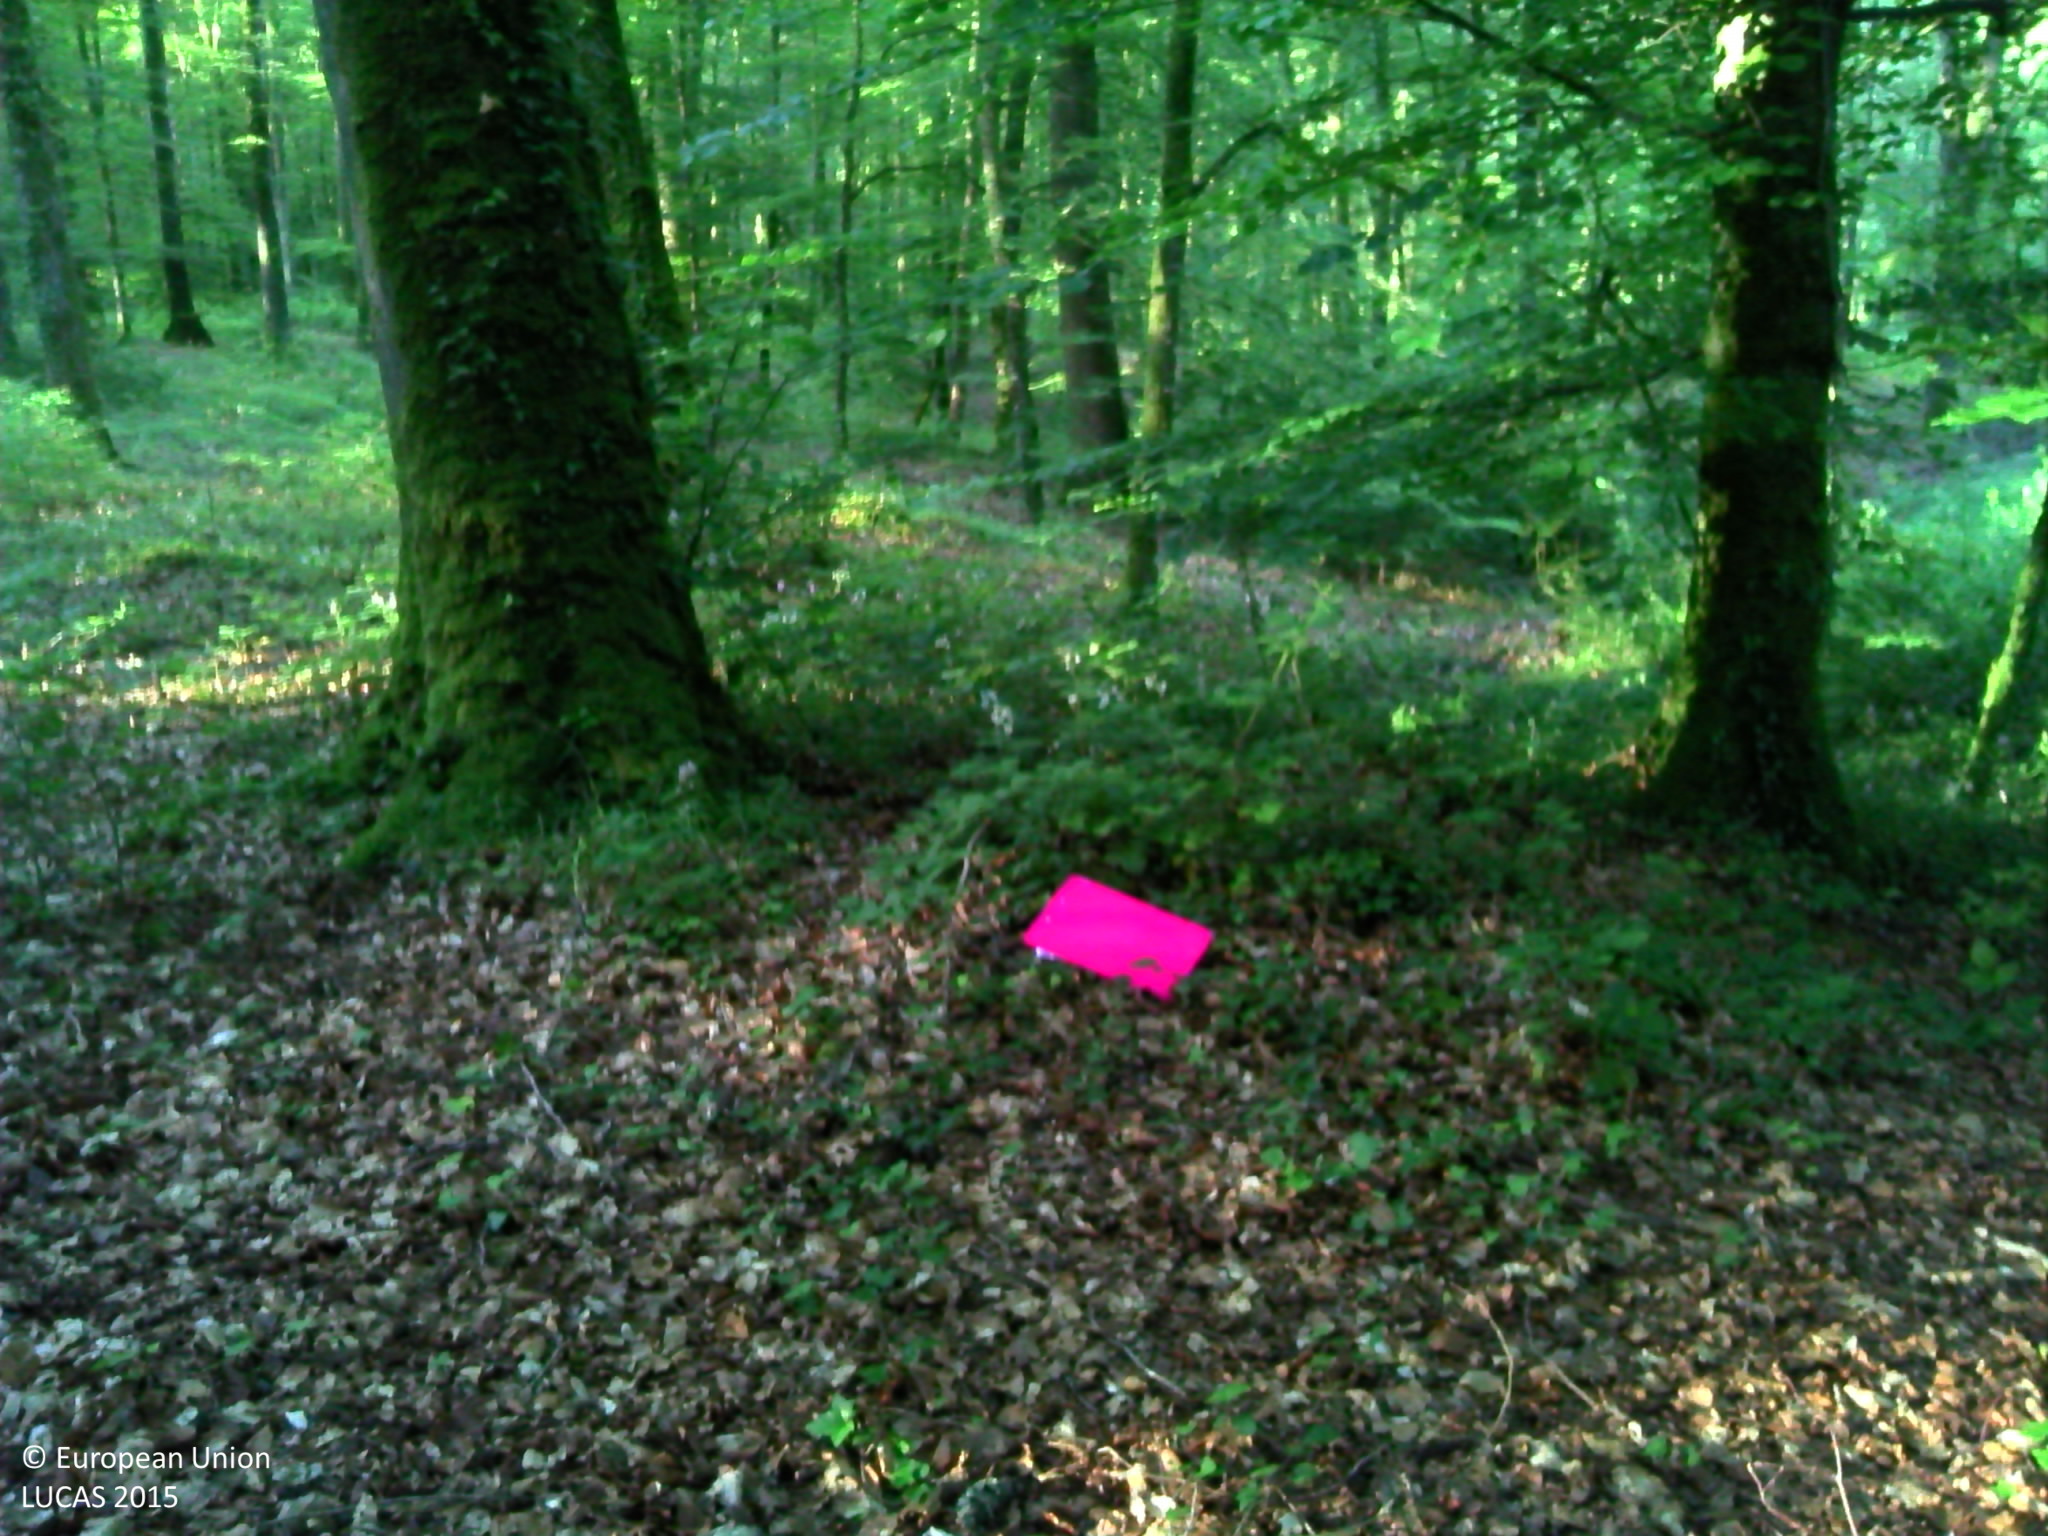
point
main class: Woodland
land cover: Broadleaved woodland
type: acidophilous oak and oak-birch forest
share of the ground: > 75 %
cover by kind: broadleaved forest trees 90 %, herbaceous plants 10 %
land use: Forestry
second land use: Amenities, museums, leisure
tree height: > 5 m
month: June
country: FR
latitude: 48.4853
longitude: -1.5617
